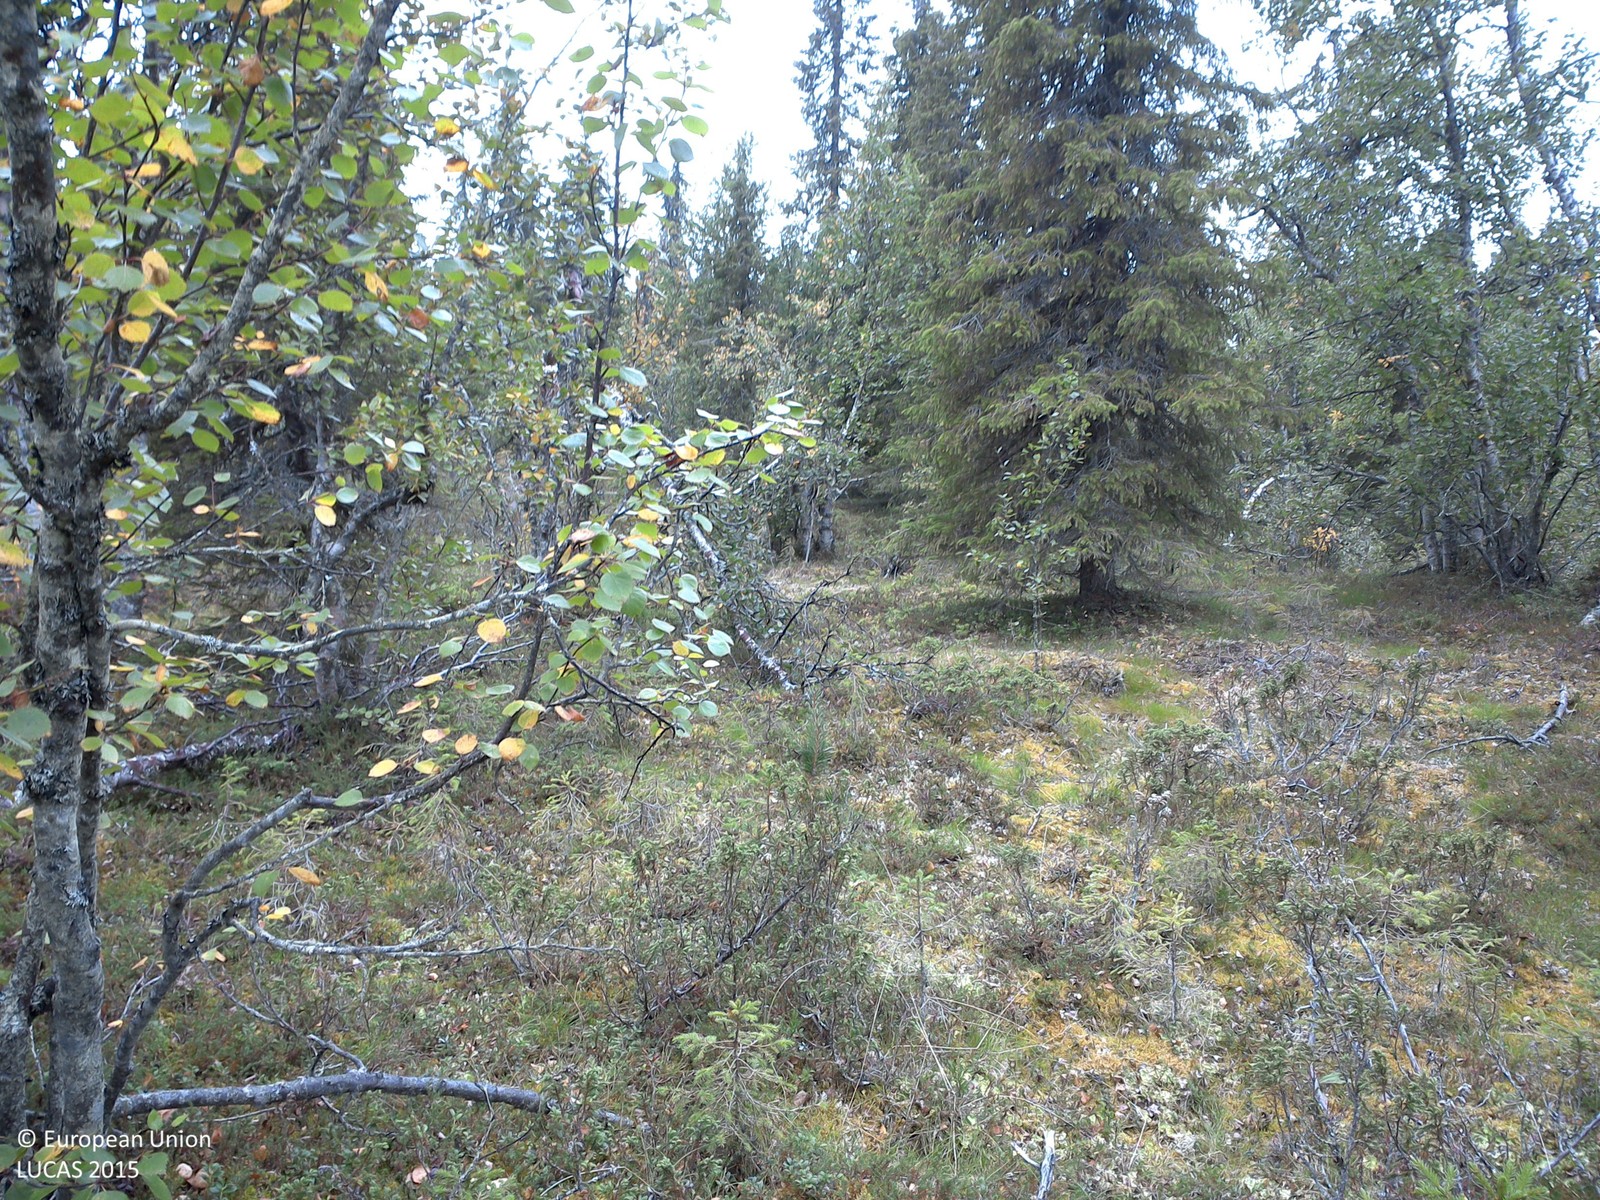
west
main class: Woodland
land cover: Spruce dominated mixed woodland
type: boreal forest
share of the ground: 25 - 50 %
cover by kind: shrubs 50 %, coniferous forest trees 20 %, broadleaved forest trees 15 %, lichens and mosses 15 %
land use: Amenities, museums, leisure
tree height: > 5 m
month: August
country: SE
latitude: 67.9966
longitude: 22.2659
